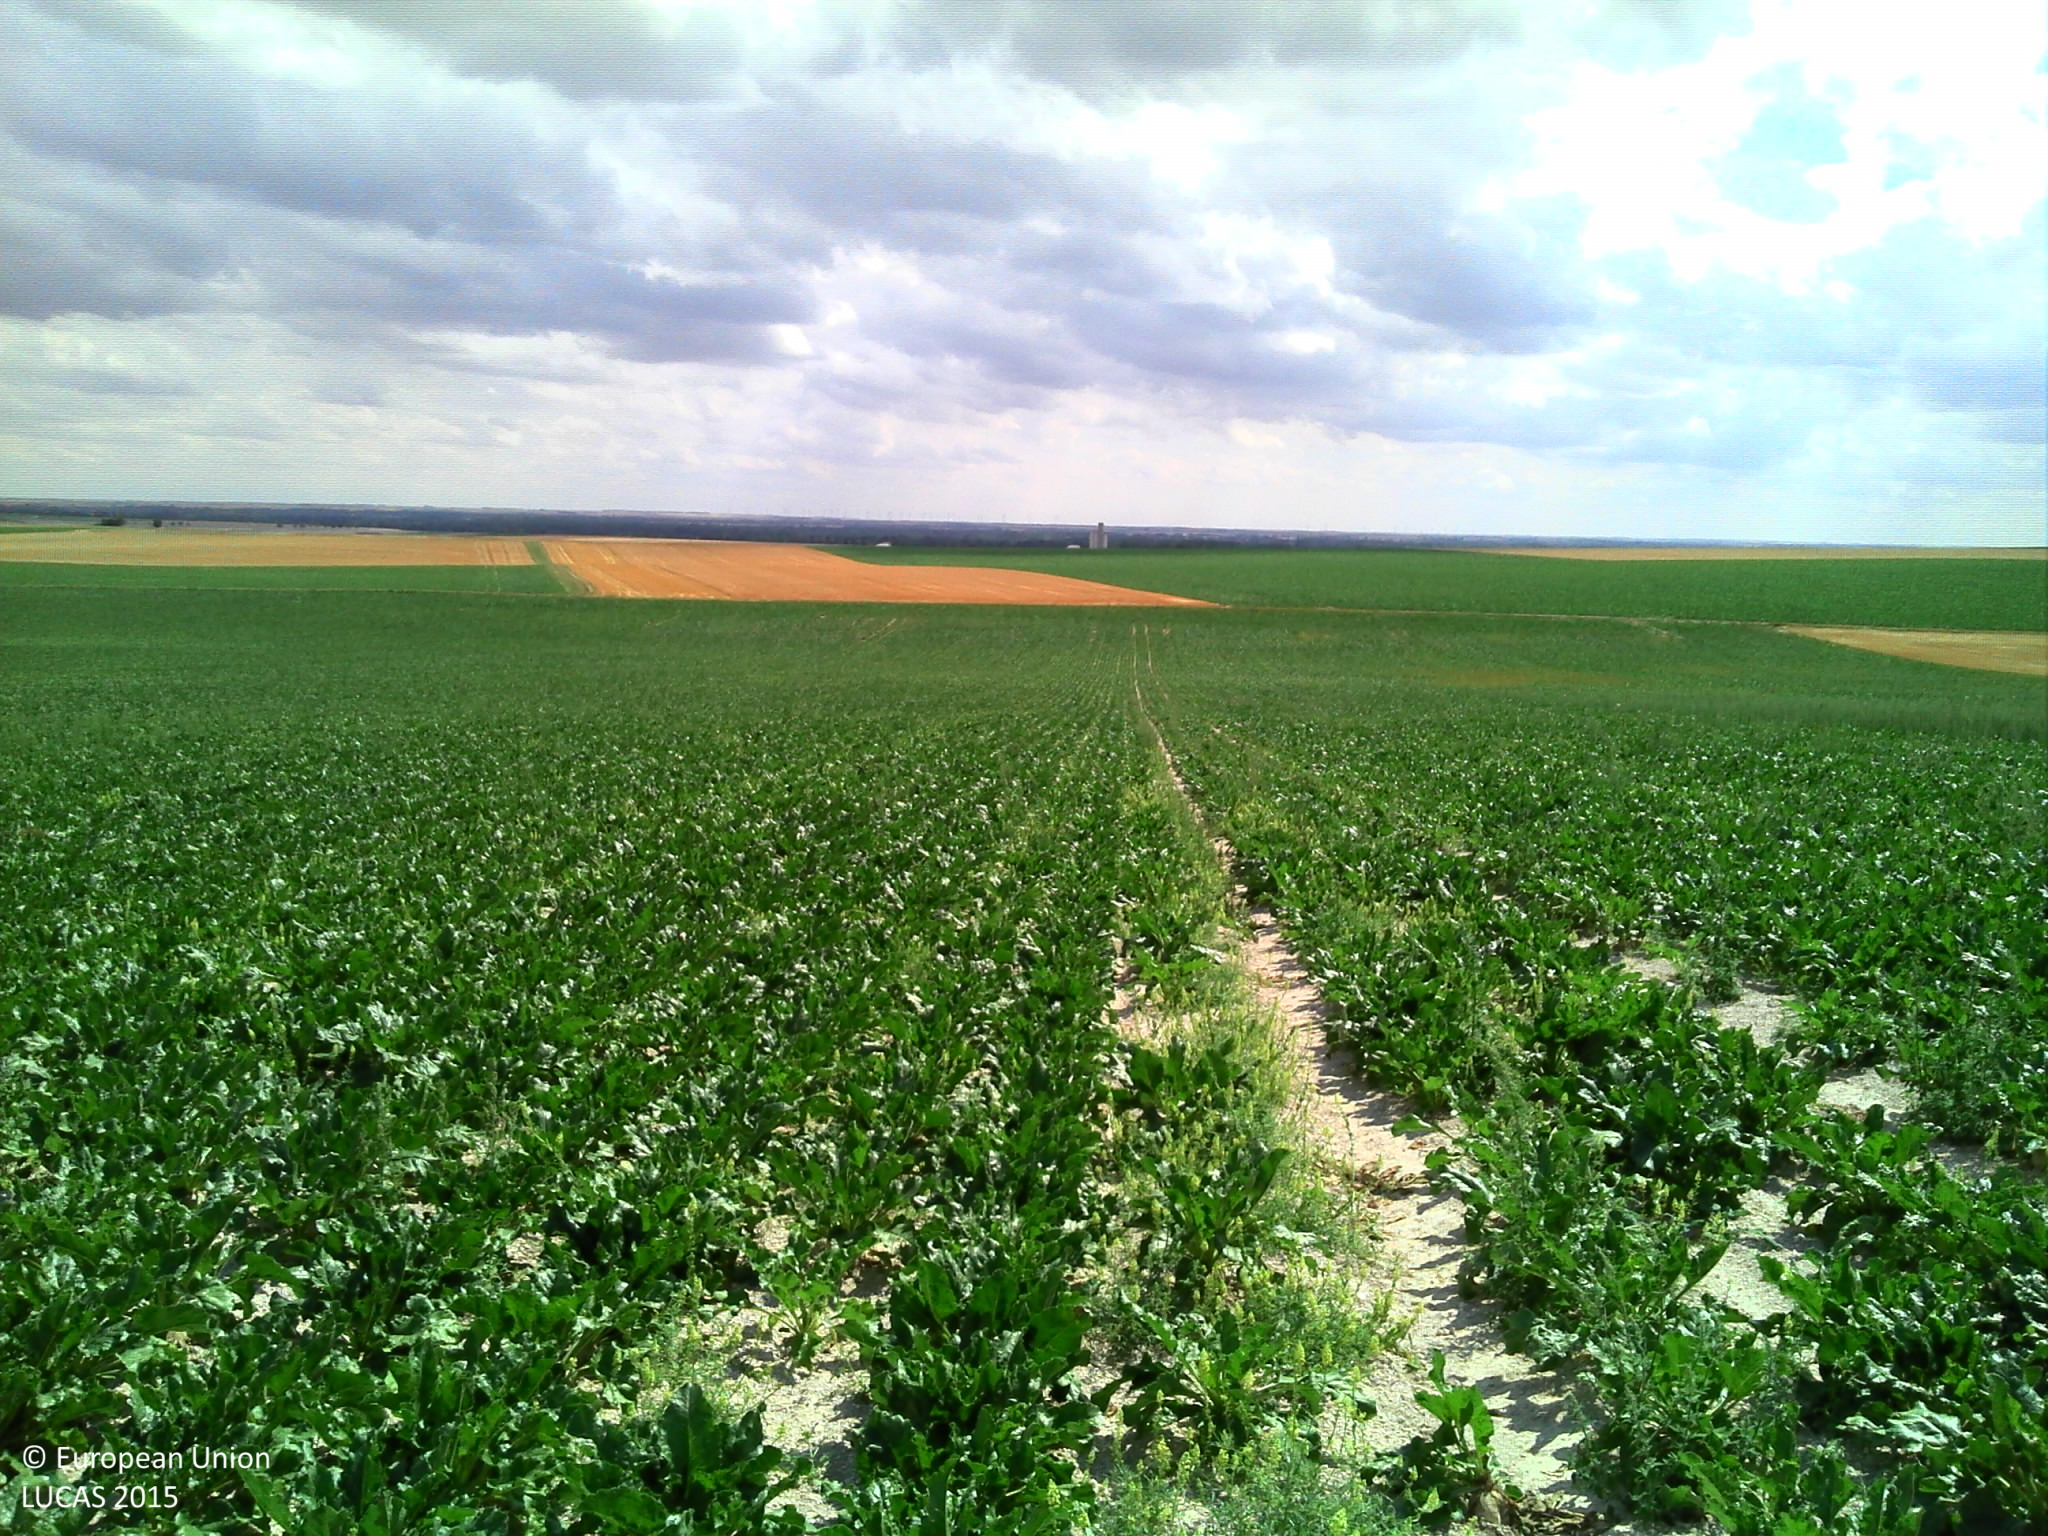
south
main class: Cropland
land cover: Sugar beet
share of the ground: > 75 %
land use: Agriculture (excluding fallow land and kitchen gardens)
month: August
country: FR
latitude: 49.0769
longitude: 4.1225
